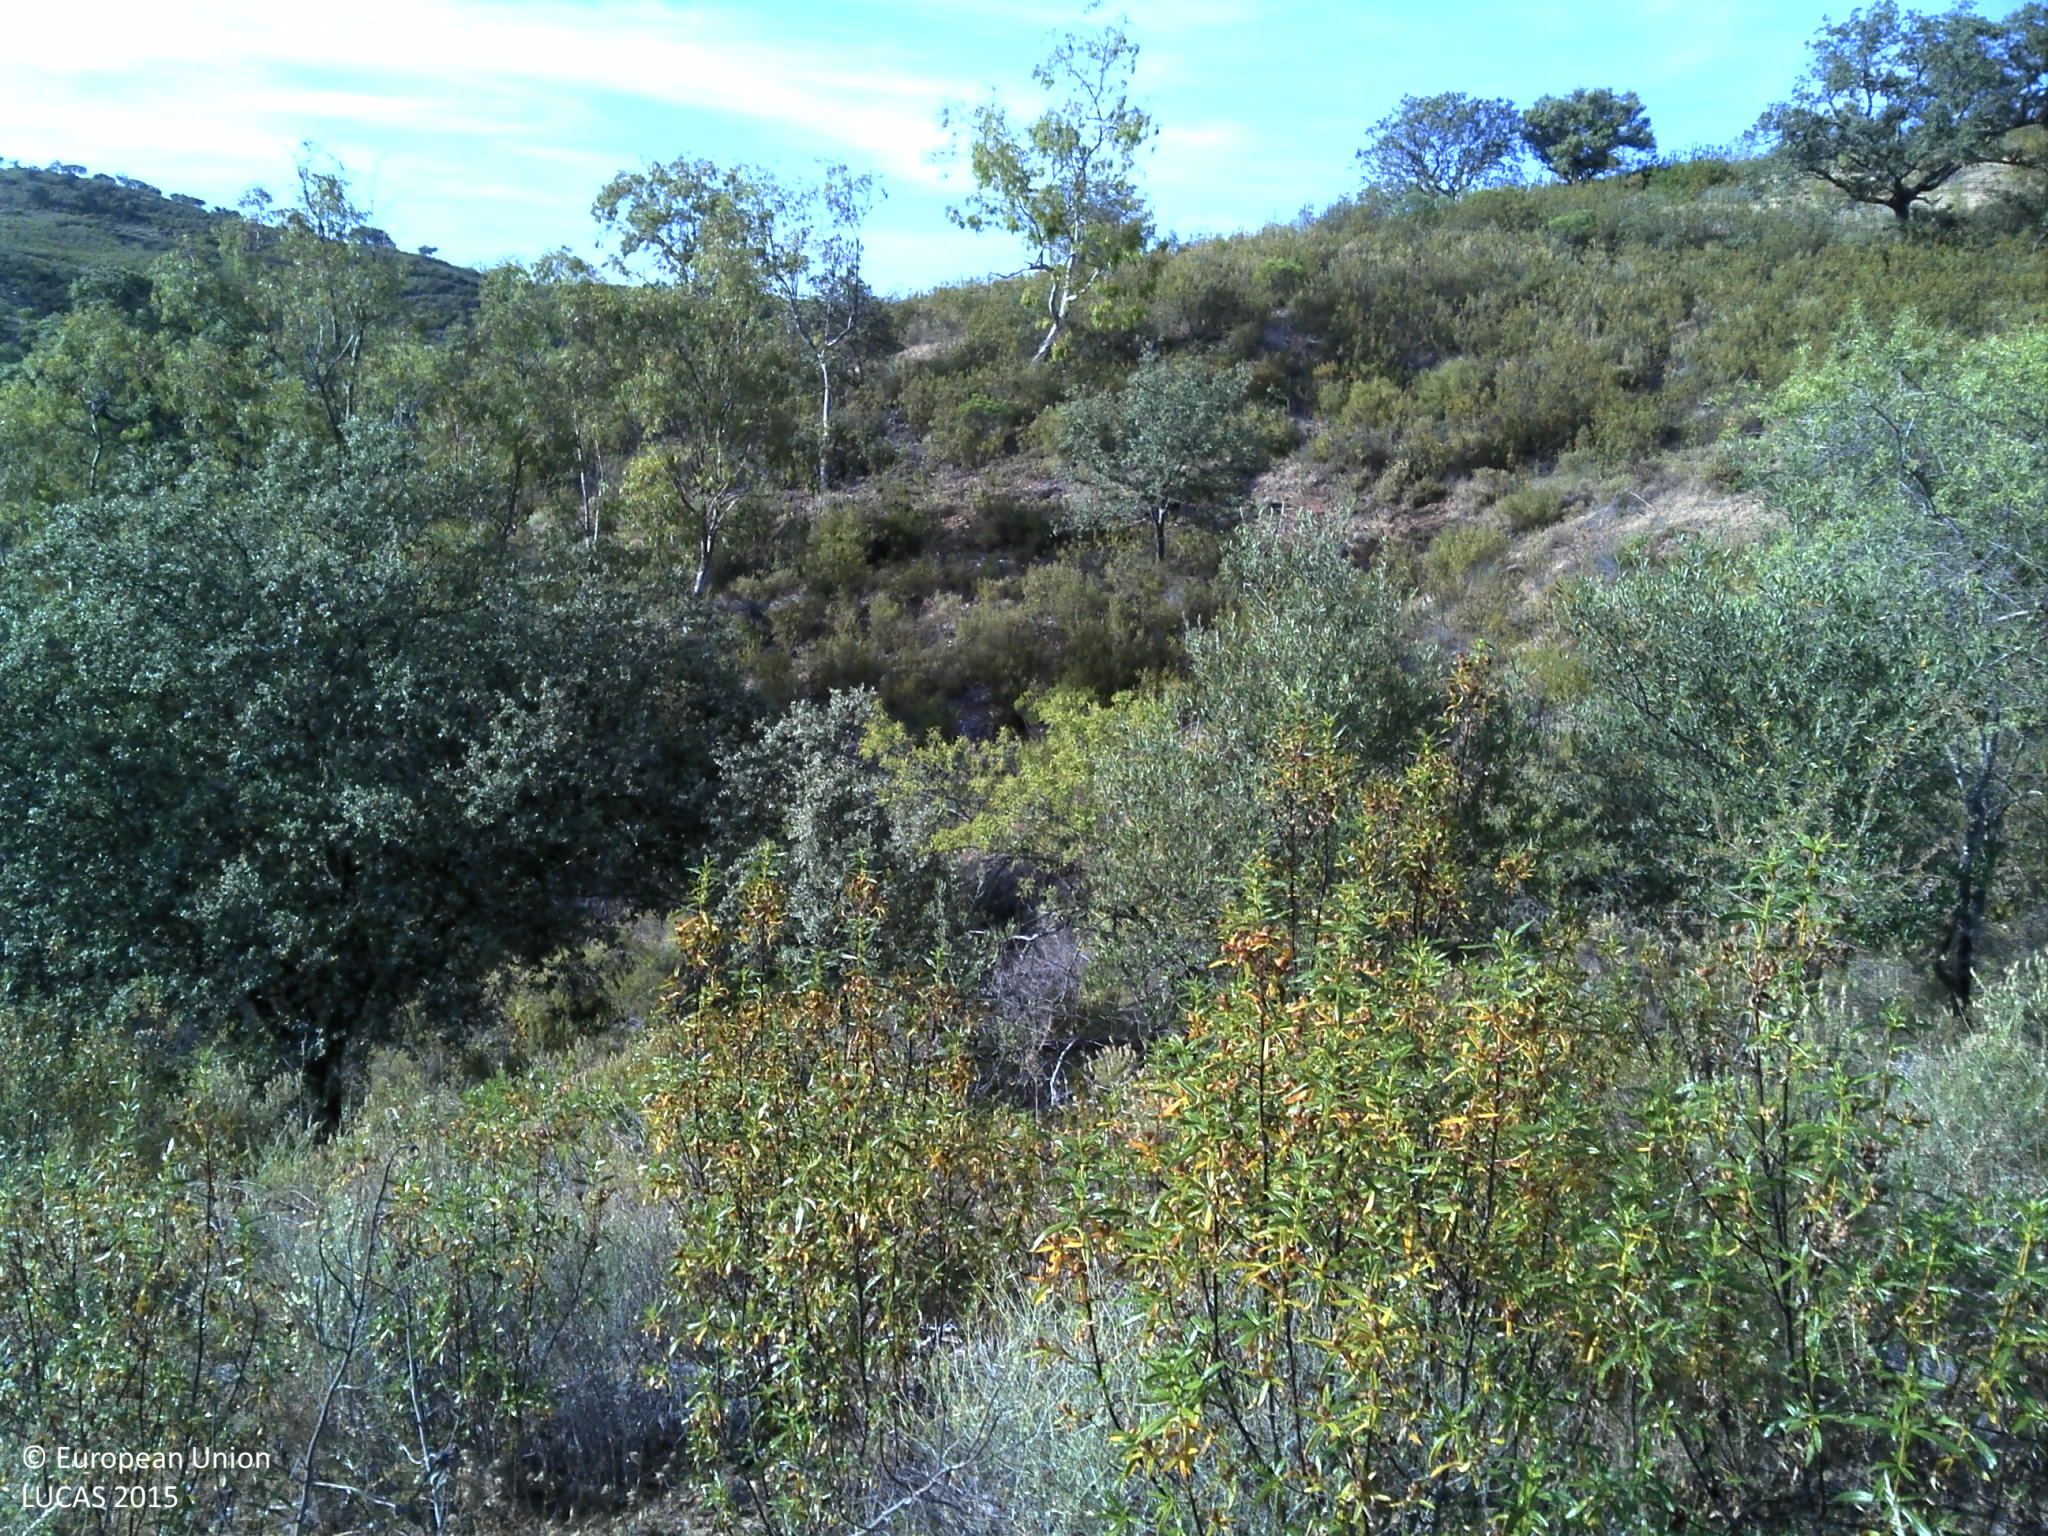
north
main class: Shrubland
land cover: Shrubland with sparse tree cover
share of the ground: 50 - 75 %
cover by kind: shrubs 75 %, unconsolidated bare surface 20 %, broadleaved forest trees 5 %
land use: Abandoned areas
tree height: > 5 m
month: May
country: PT
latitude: 37.2987
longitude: -7.4794
